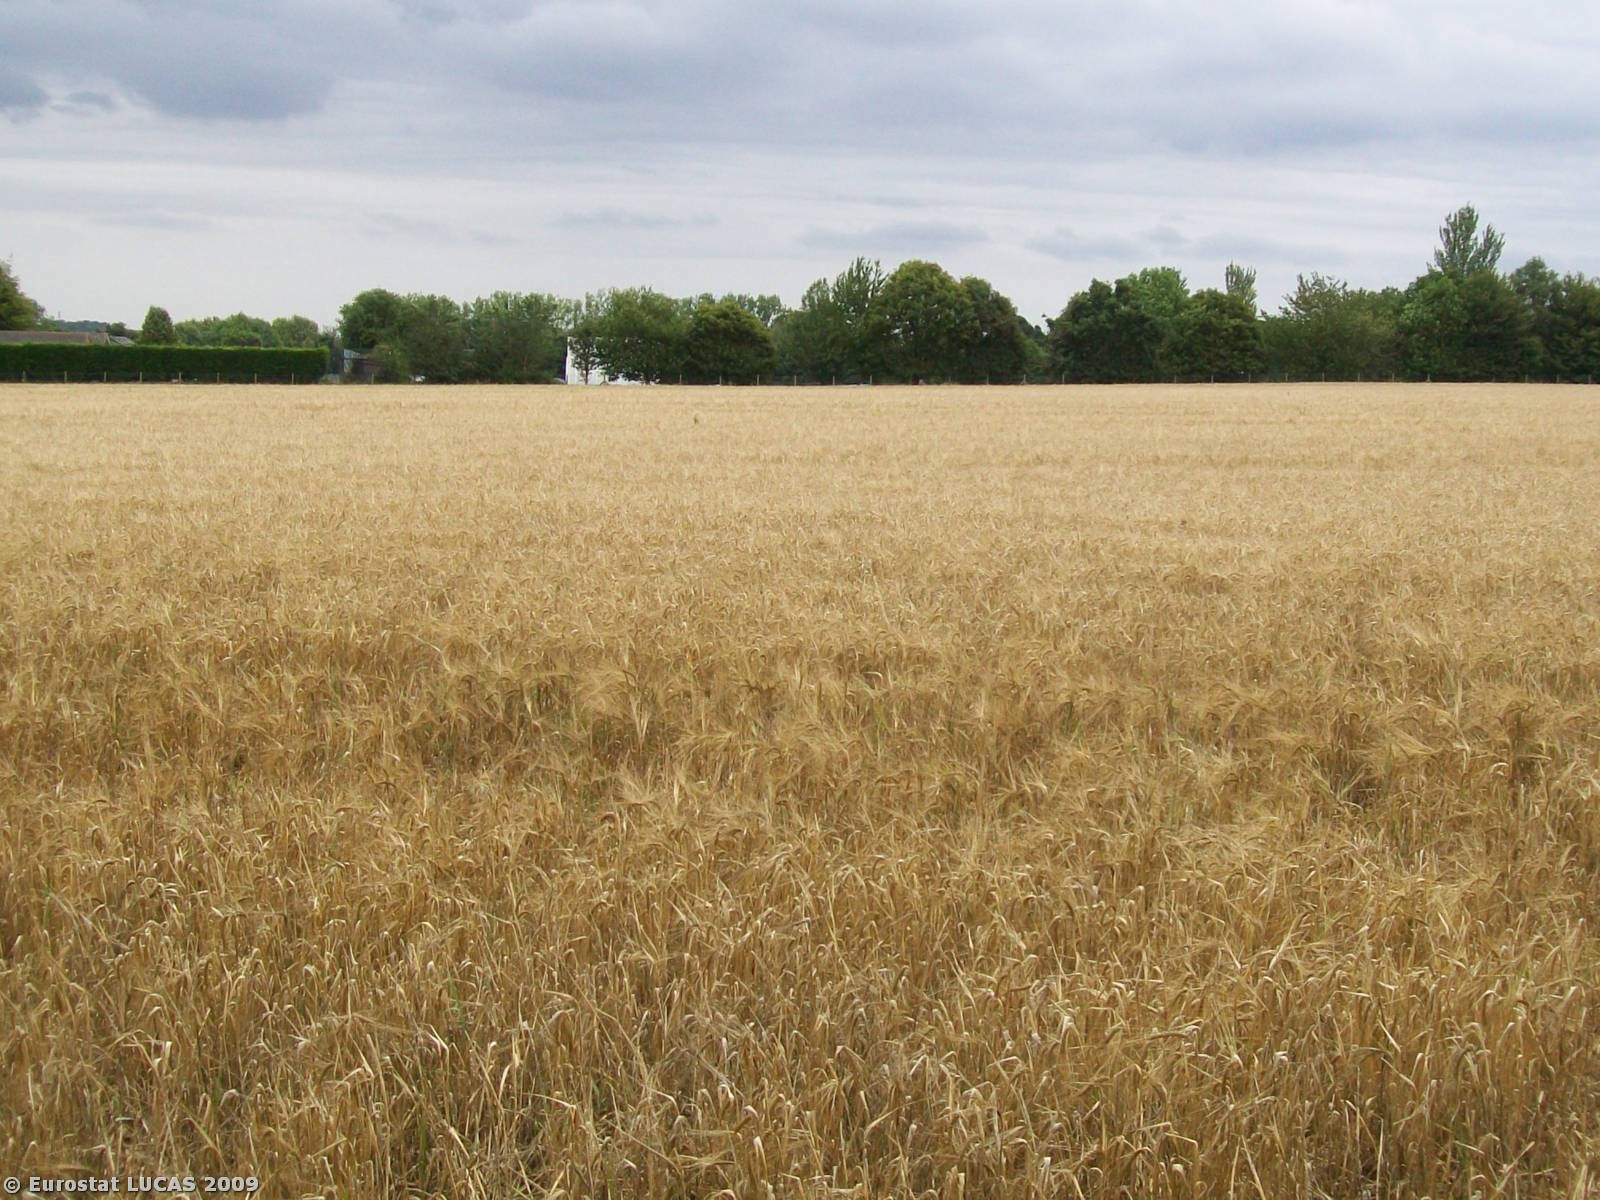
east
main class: Cropland
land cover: Barley
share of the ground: > 75 %
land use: Agriculture (excluding fallow land and kitchen gardens)
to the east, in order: Barley; Managed hedges; Grassland without tree/shrub cover
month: August
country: GB
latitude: 51.4777
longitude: -1.0601
